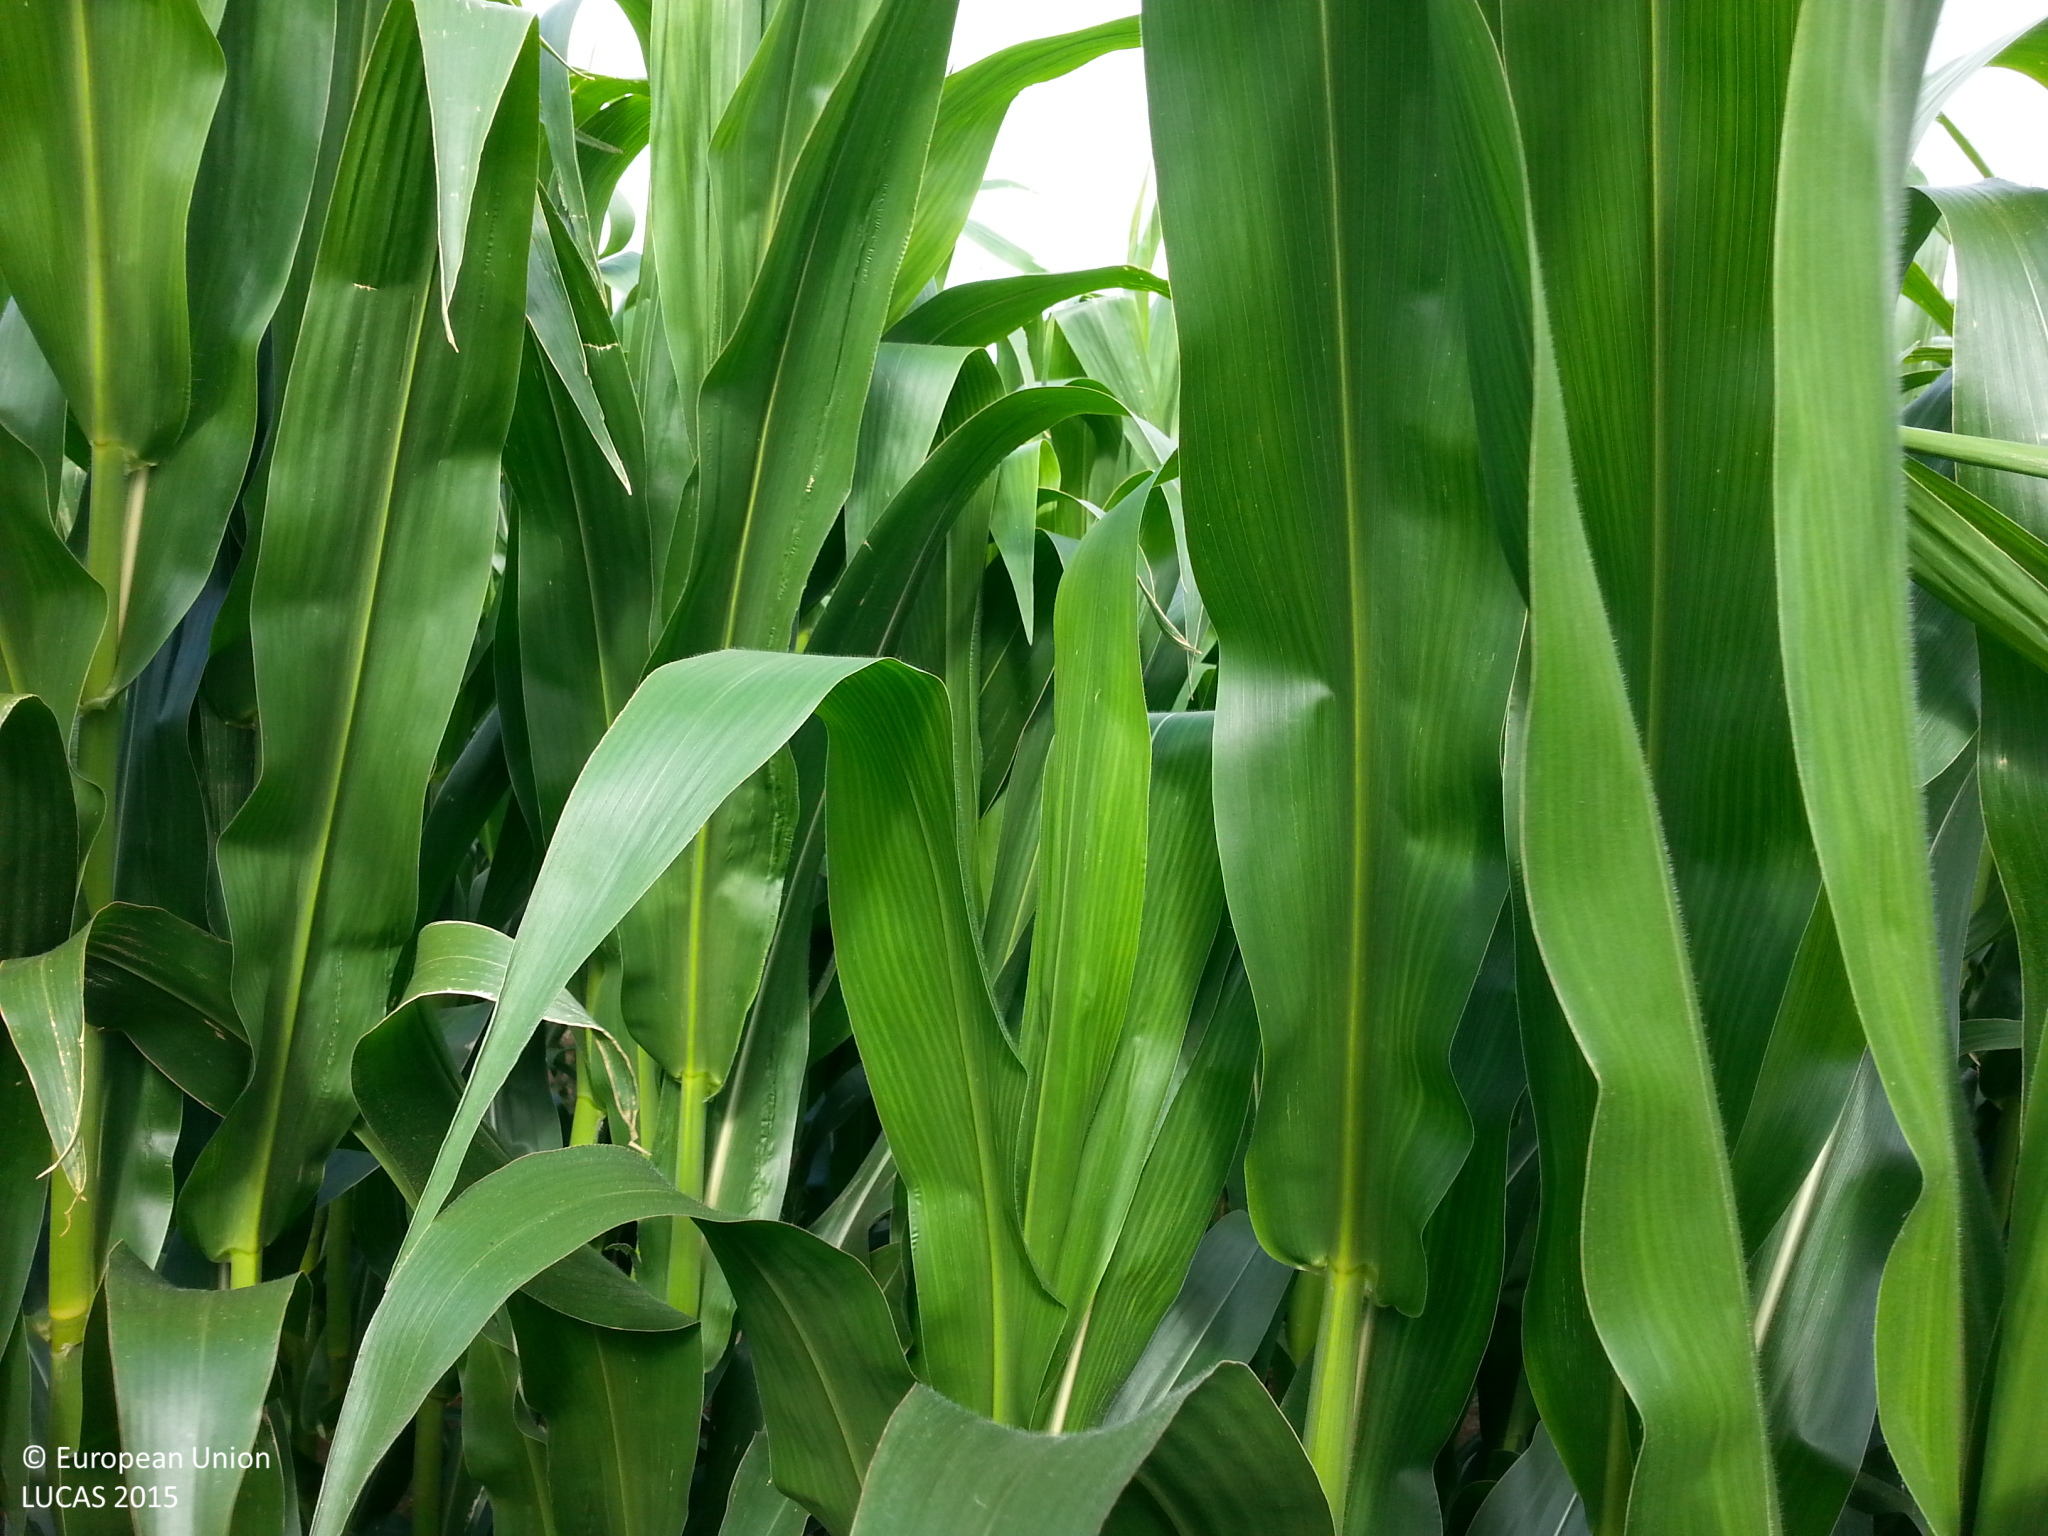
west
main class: Cropland
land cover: Maize
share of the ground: > 75 %
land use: Agriculture (excluding fallow land and kitchen gardens)
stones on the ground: < 10 %
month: July
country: DE
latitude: 53.2155
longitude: 12.4404
